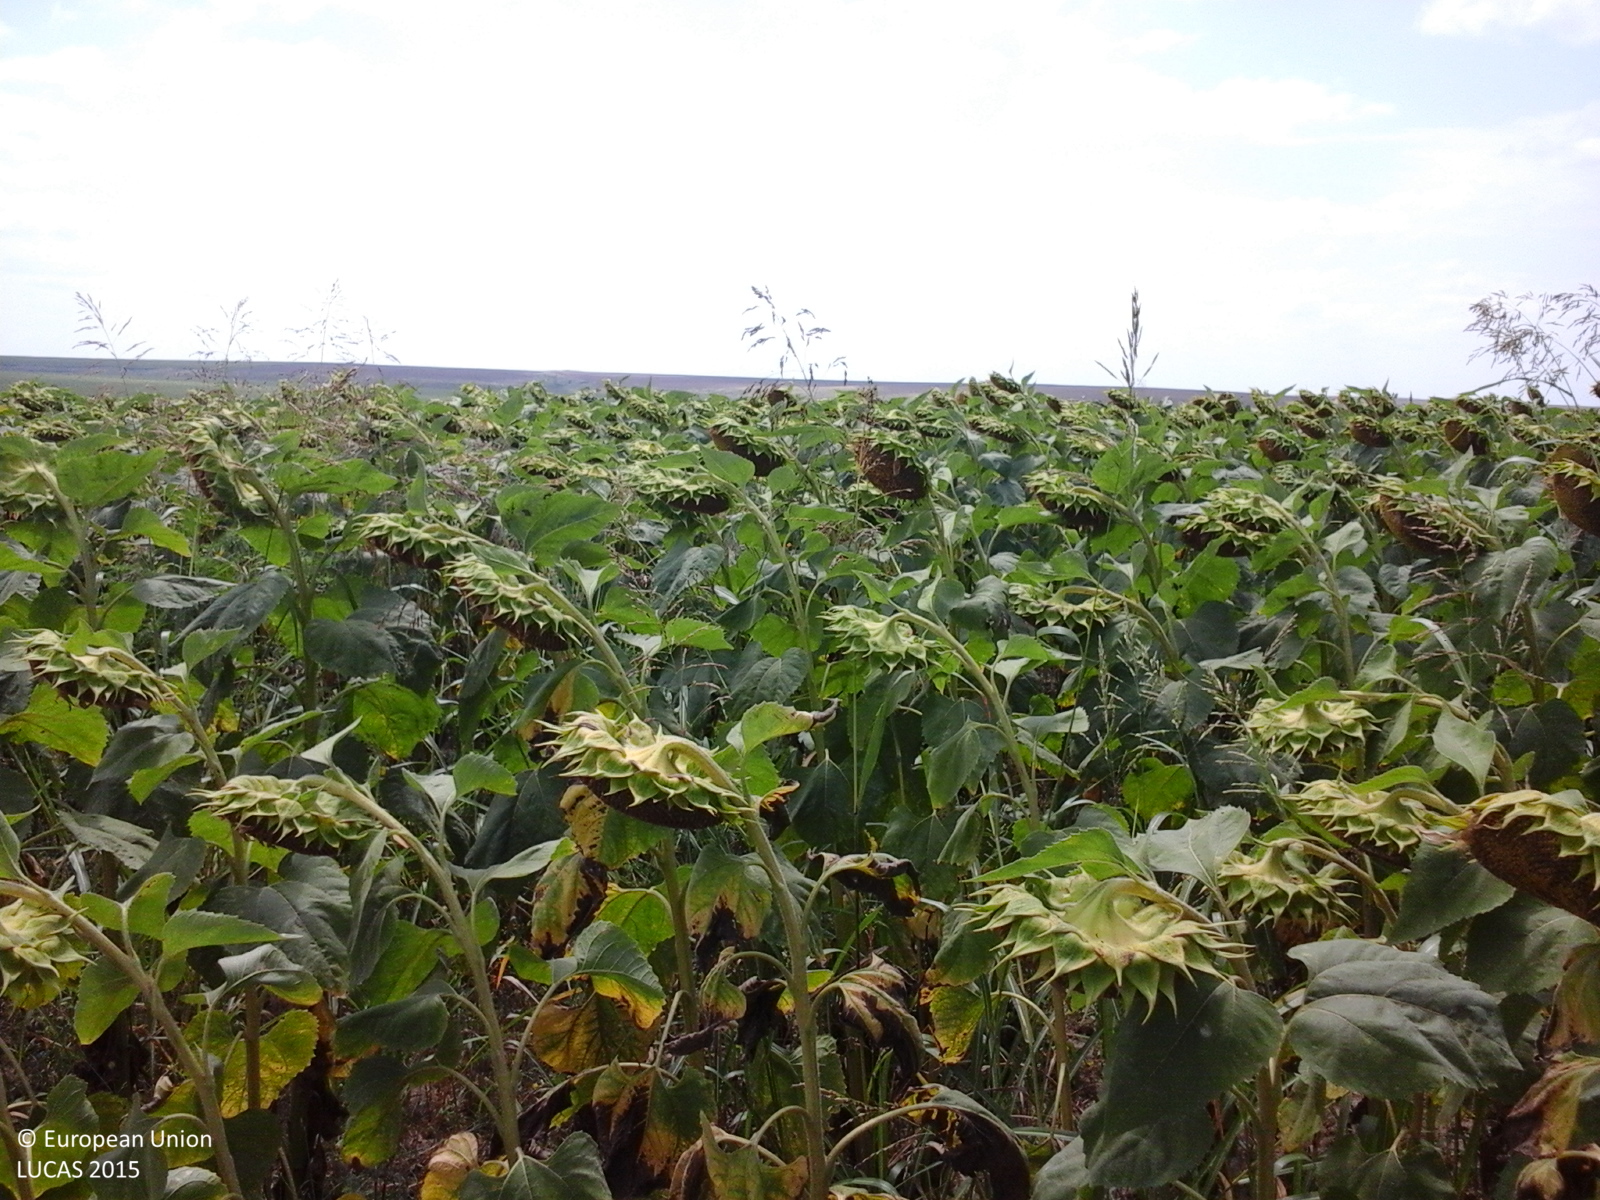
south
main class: Cropland
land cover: Sunflower
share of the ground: > 75 %
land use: Agriculture (excluding fallow land and kitchen gardens)
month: August
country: RO
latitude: 44.7815
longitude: 28.1496
